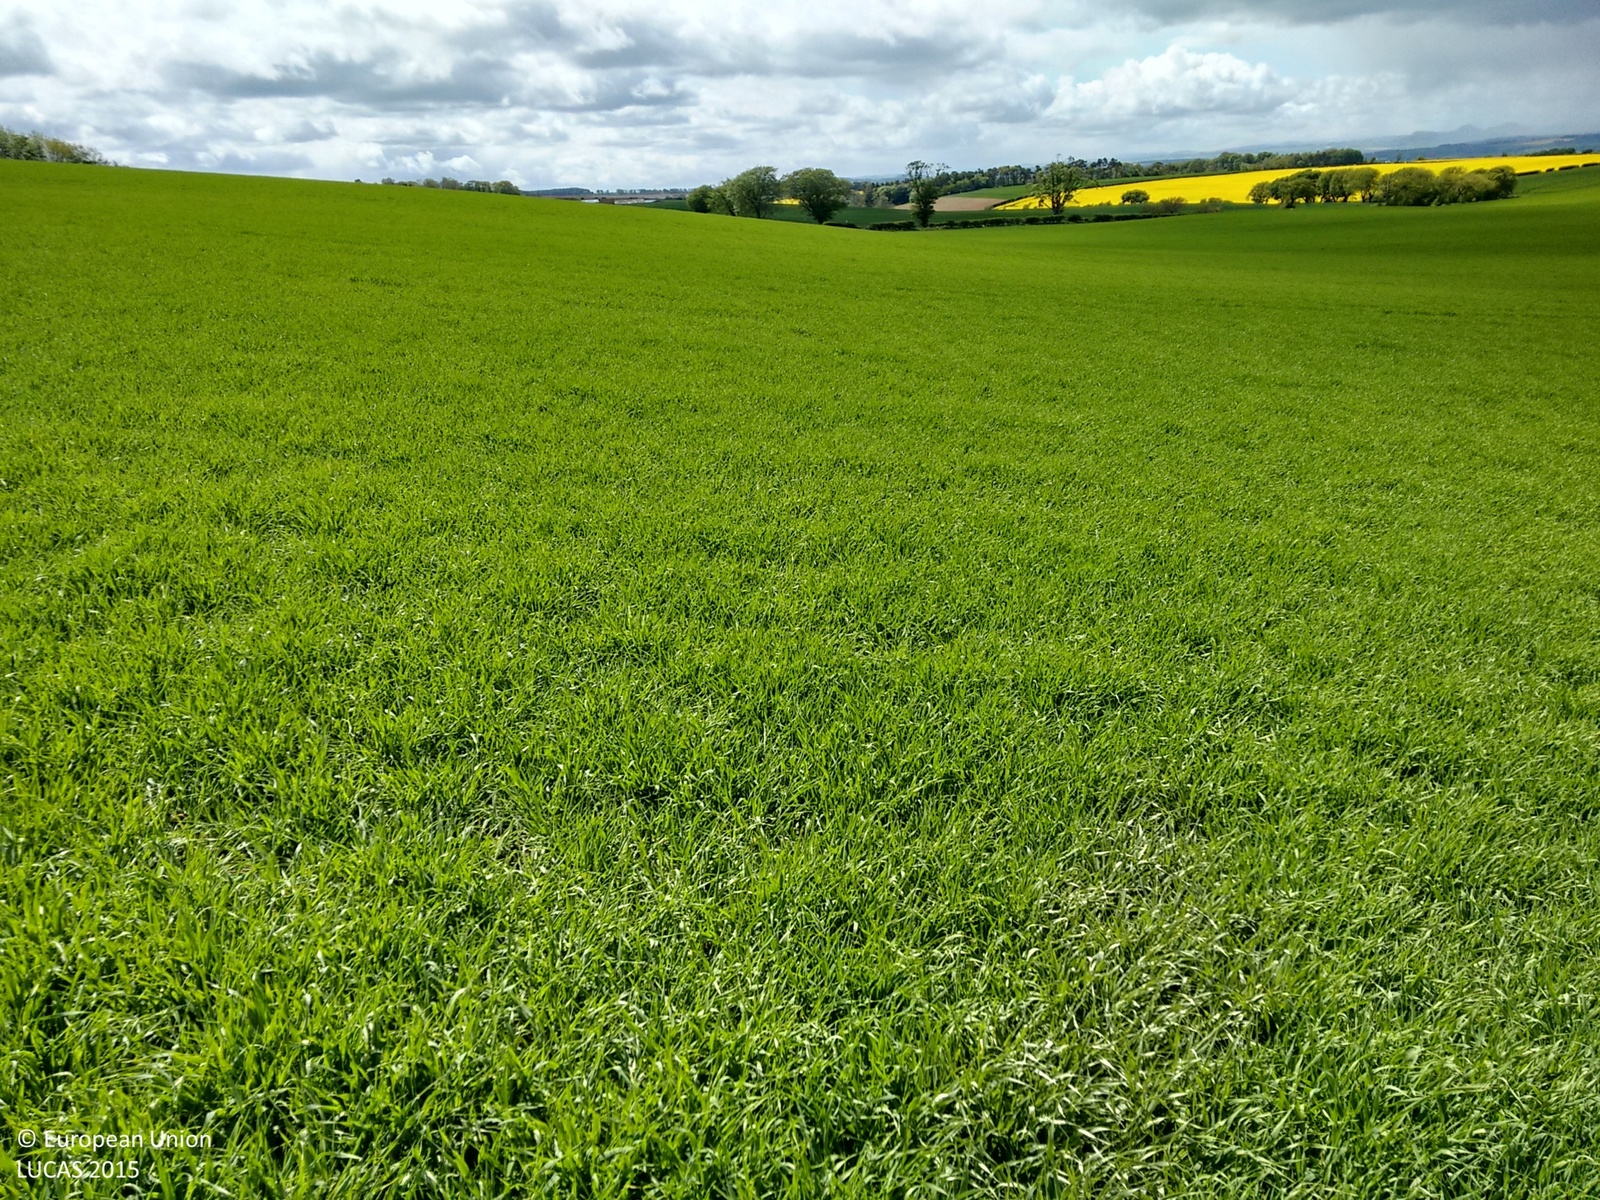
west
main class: Cropland
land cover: Barley
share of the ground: > 75 %
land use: Agriculture (excluding fallow land and kitchen gardens)
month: May
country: GB
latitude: 55.5879
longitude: -2.3546
